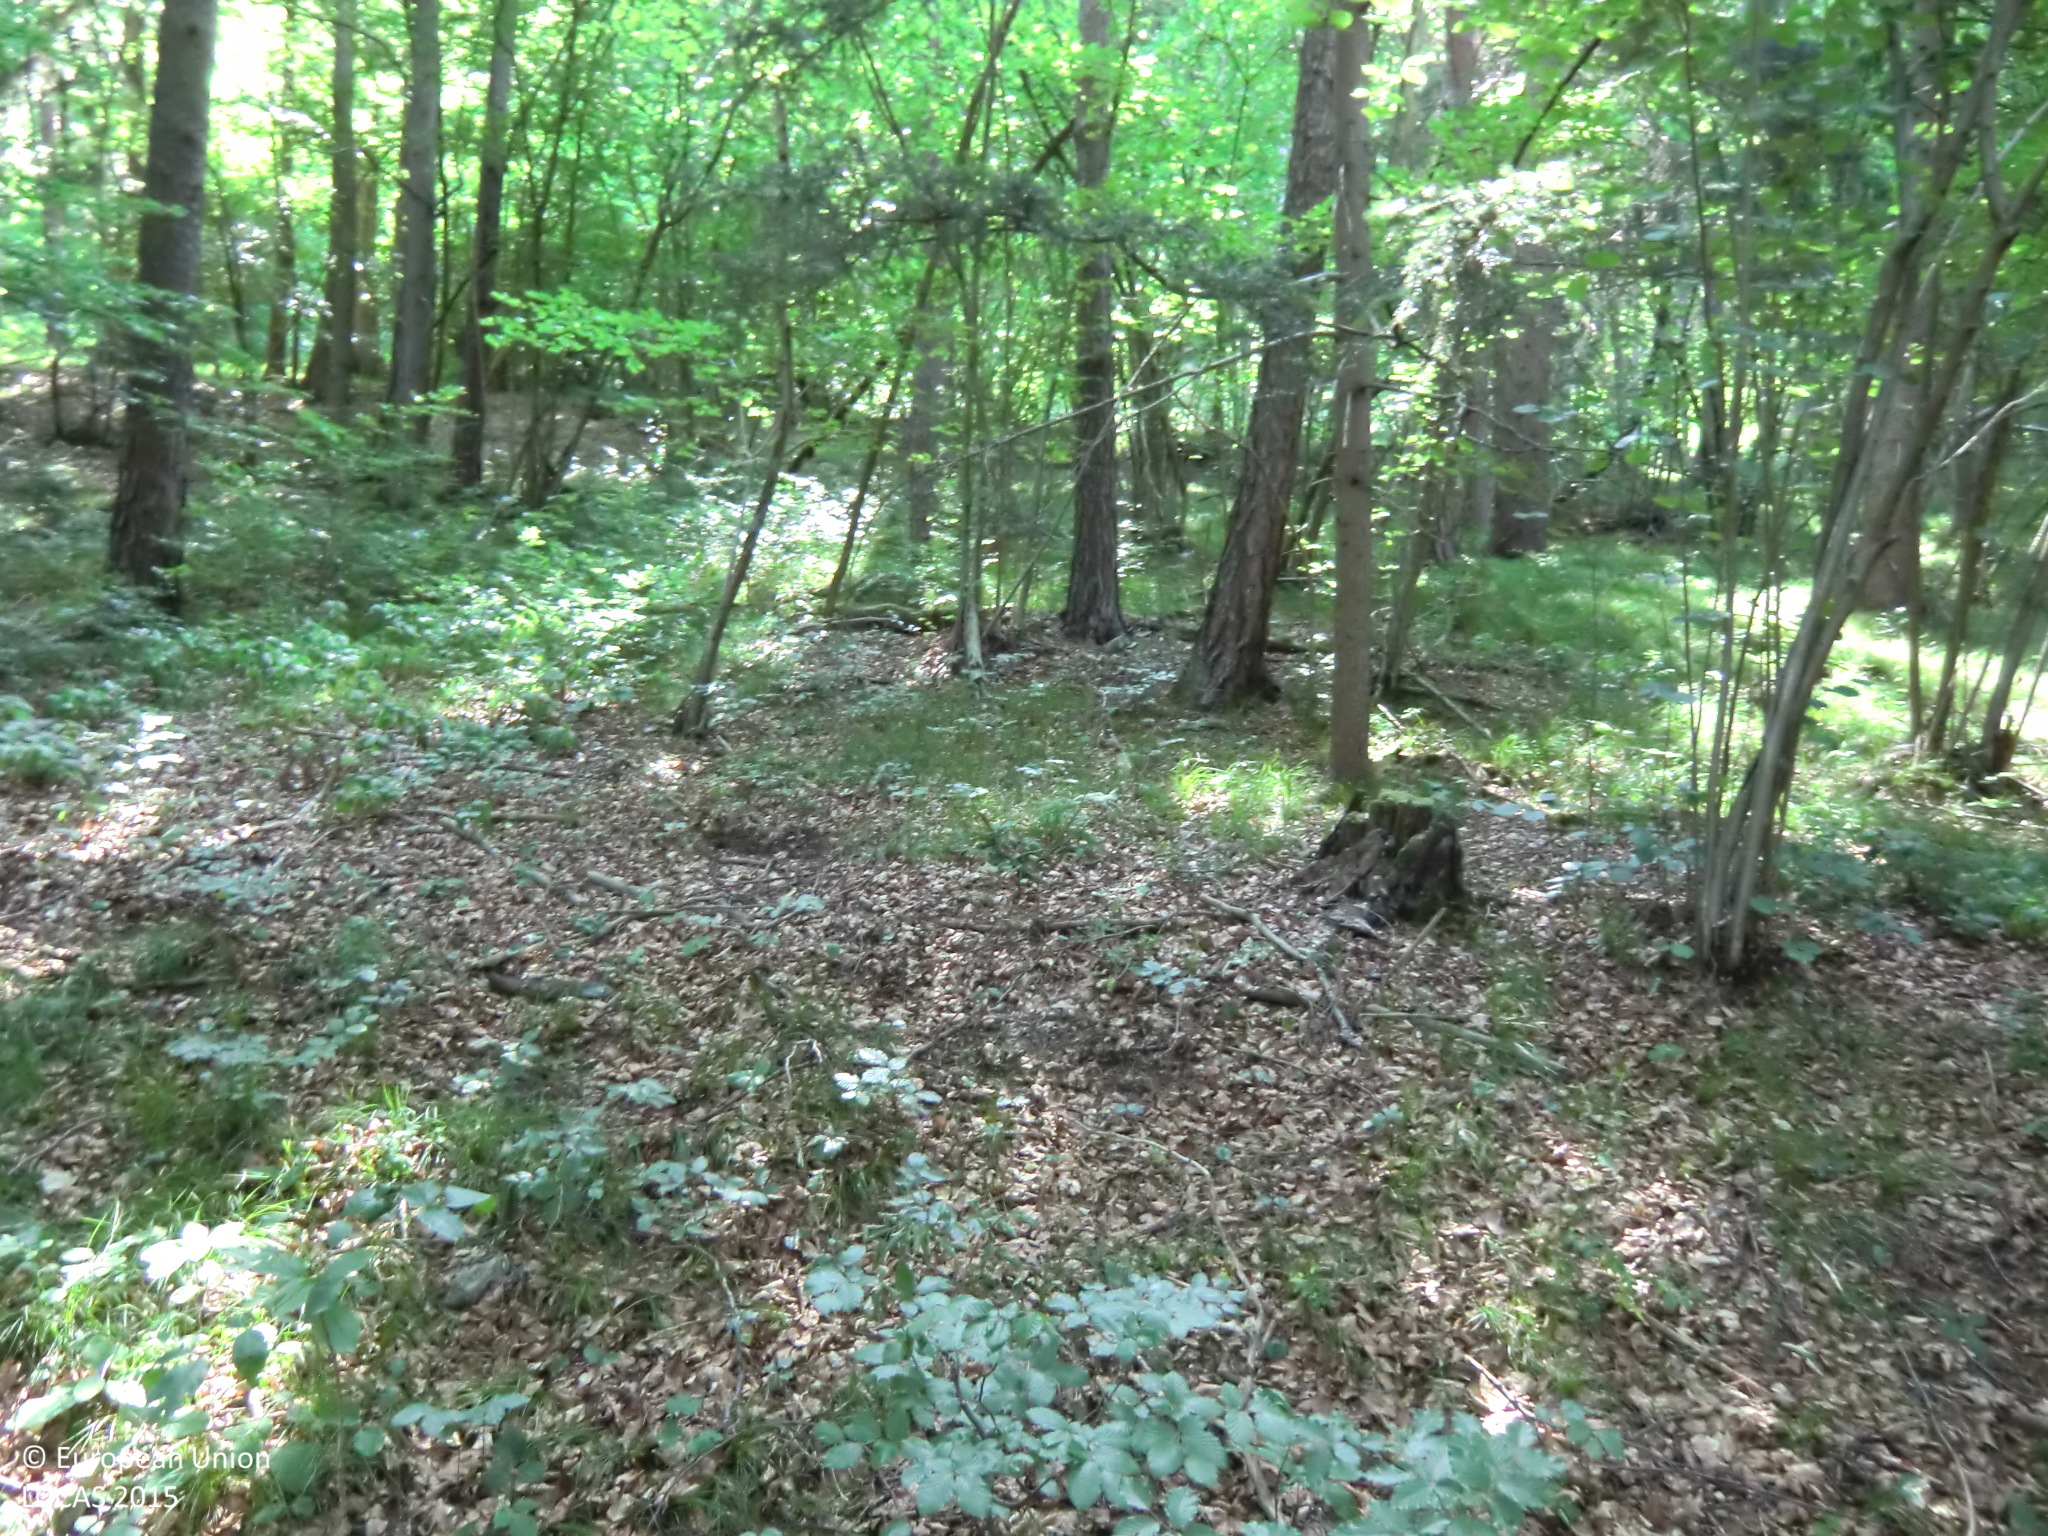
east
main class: Woodland
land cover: Other mixed woodland
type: hemiboreal forest and nemoral coniferous forest and mixed broadleaved-coniferous forest
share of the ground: > 75 %
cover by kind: coniferous forest trees 45 %, broadleaved forest trees 40 %, herbaceous plants 10 %, unconsolidated bare surface 5 %
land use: Forestry
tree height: > 5 m
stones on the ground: < 10 %
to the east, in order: Other mixed woodland; Pine dominated coniferous woodland; Other coniferous woodland; Other mixed woodland; Tracks; Fences; Other mixed woodland; Tracks; Other mixed woodland
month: July
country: AT
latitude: 47.1522
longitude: 15.4205
